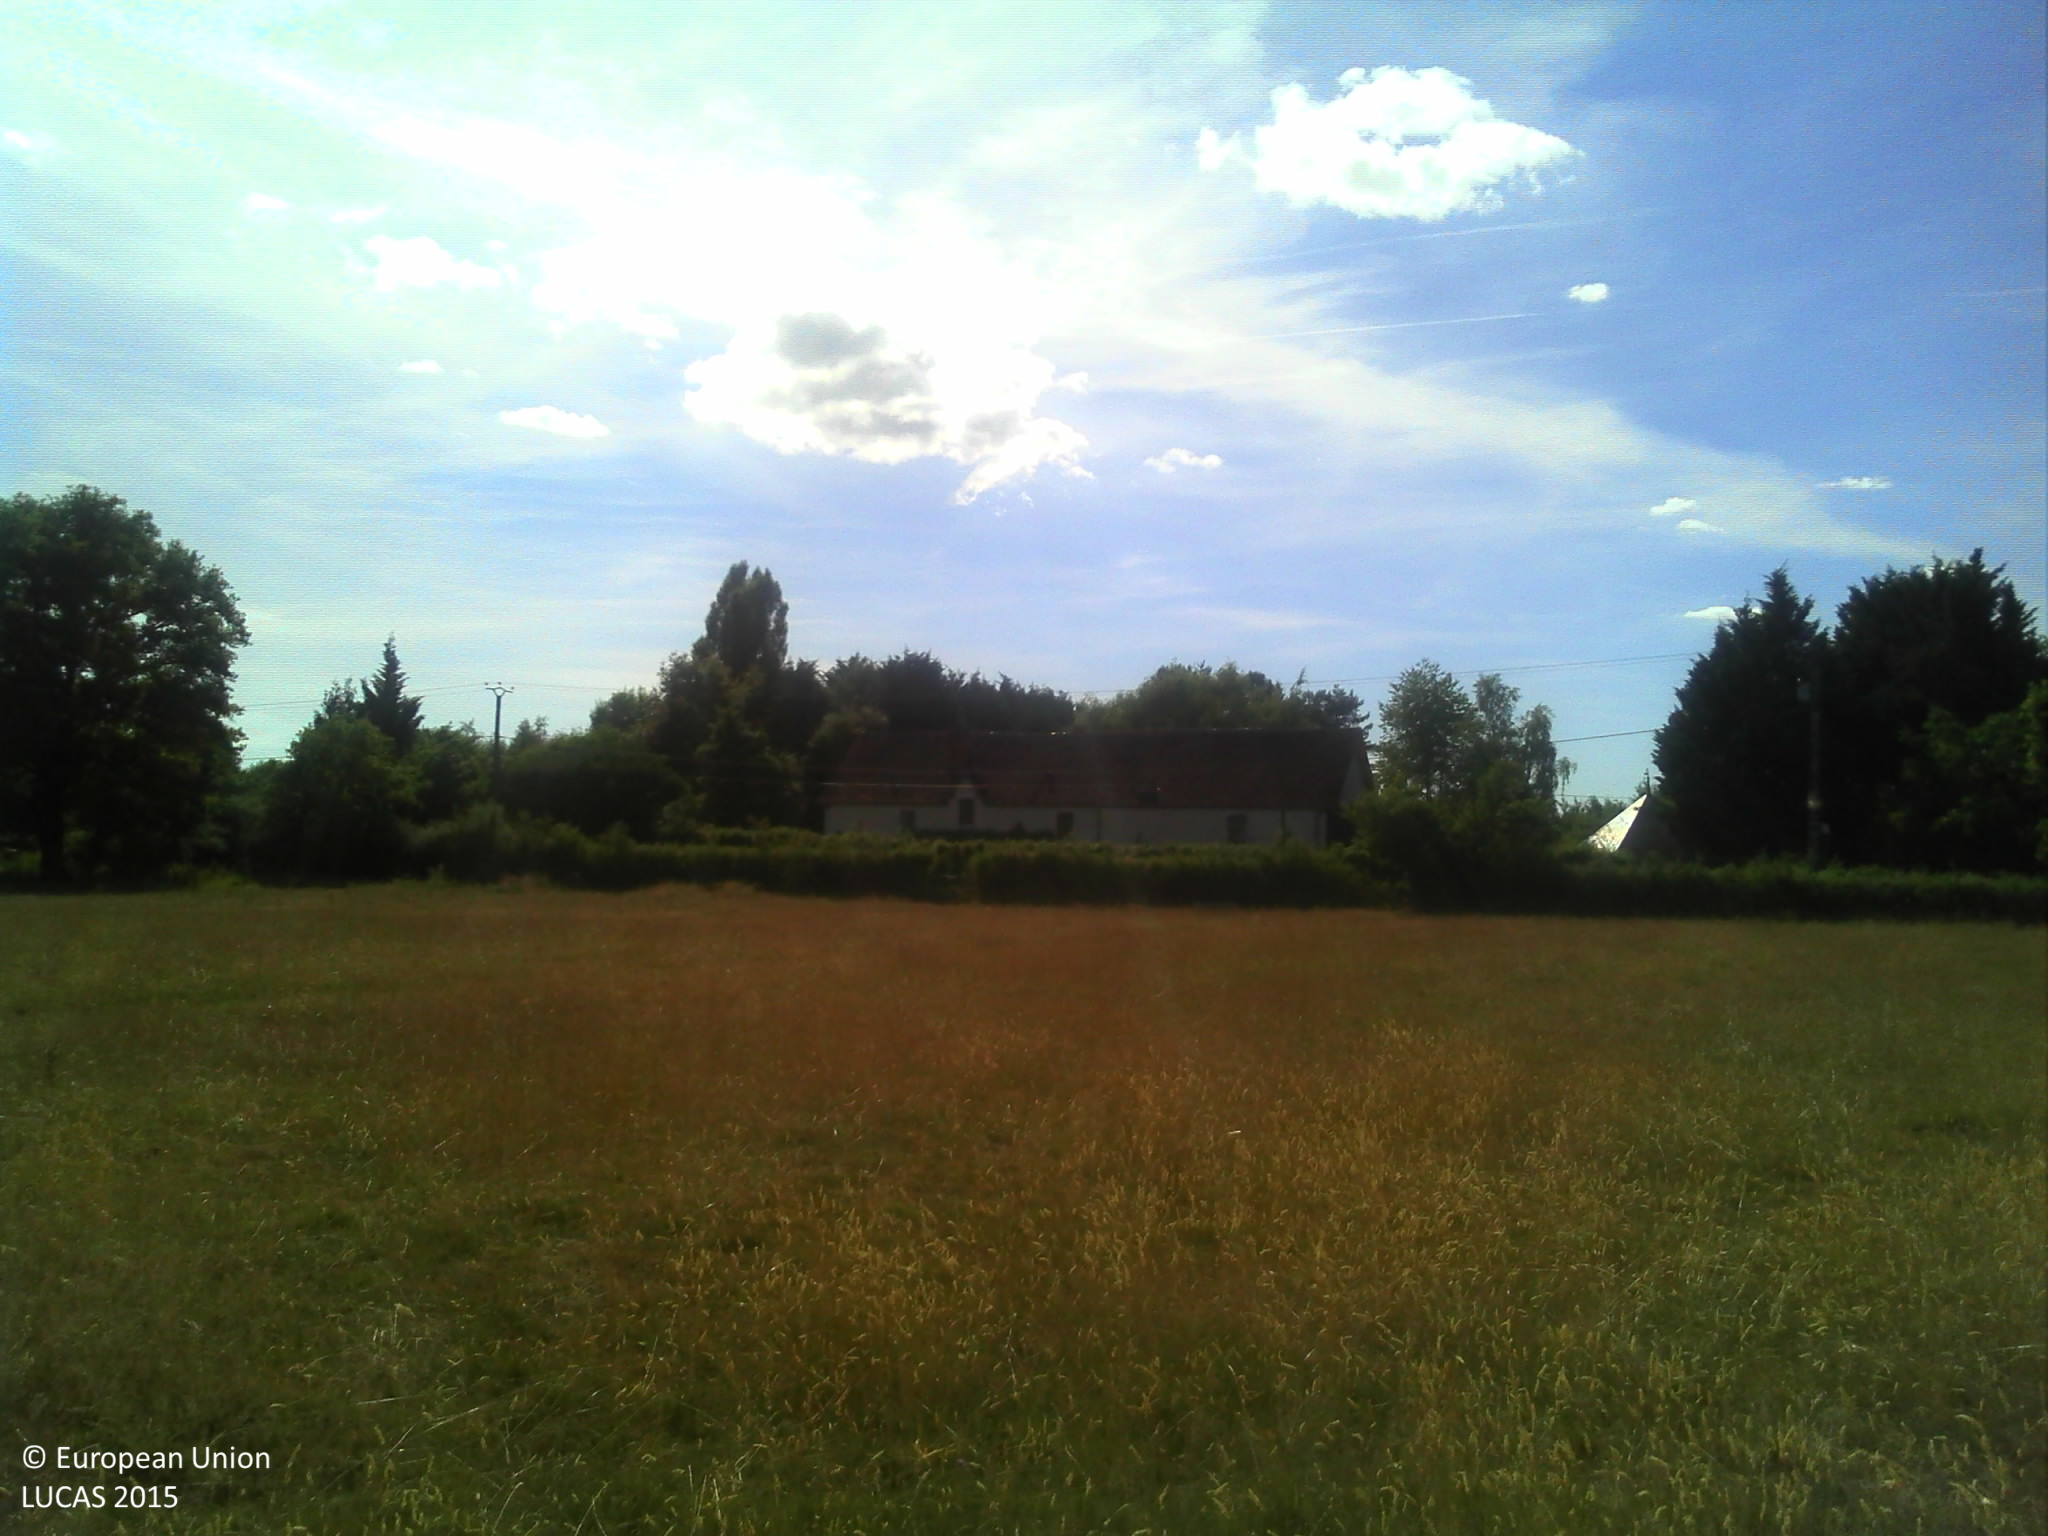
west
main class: Grassland
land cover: Grassland without tree/shrub cover
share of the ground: > 75 %
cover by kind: herbaceous plants 100 %
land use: Agriculture (excluding fallow land and kitchen gardens)
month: June
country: FR
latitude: 47.7230
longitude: 2.6195
